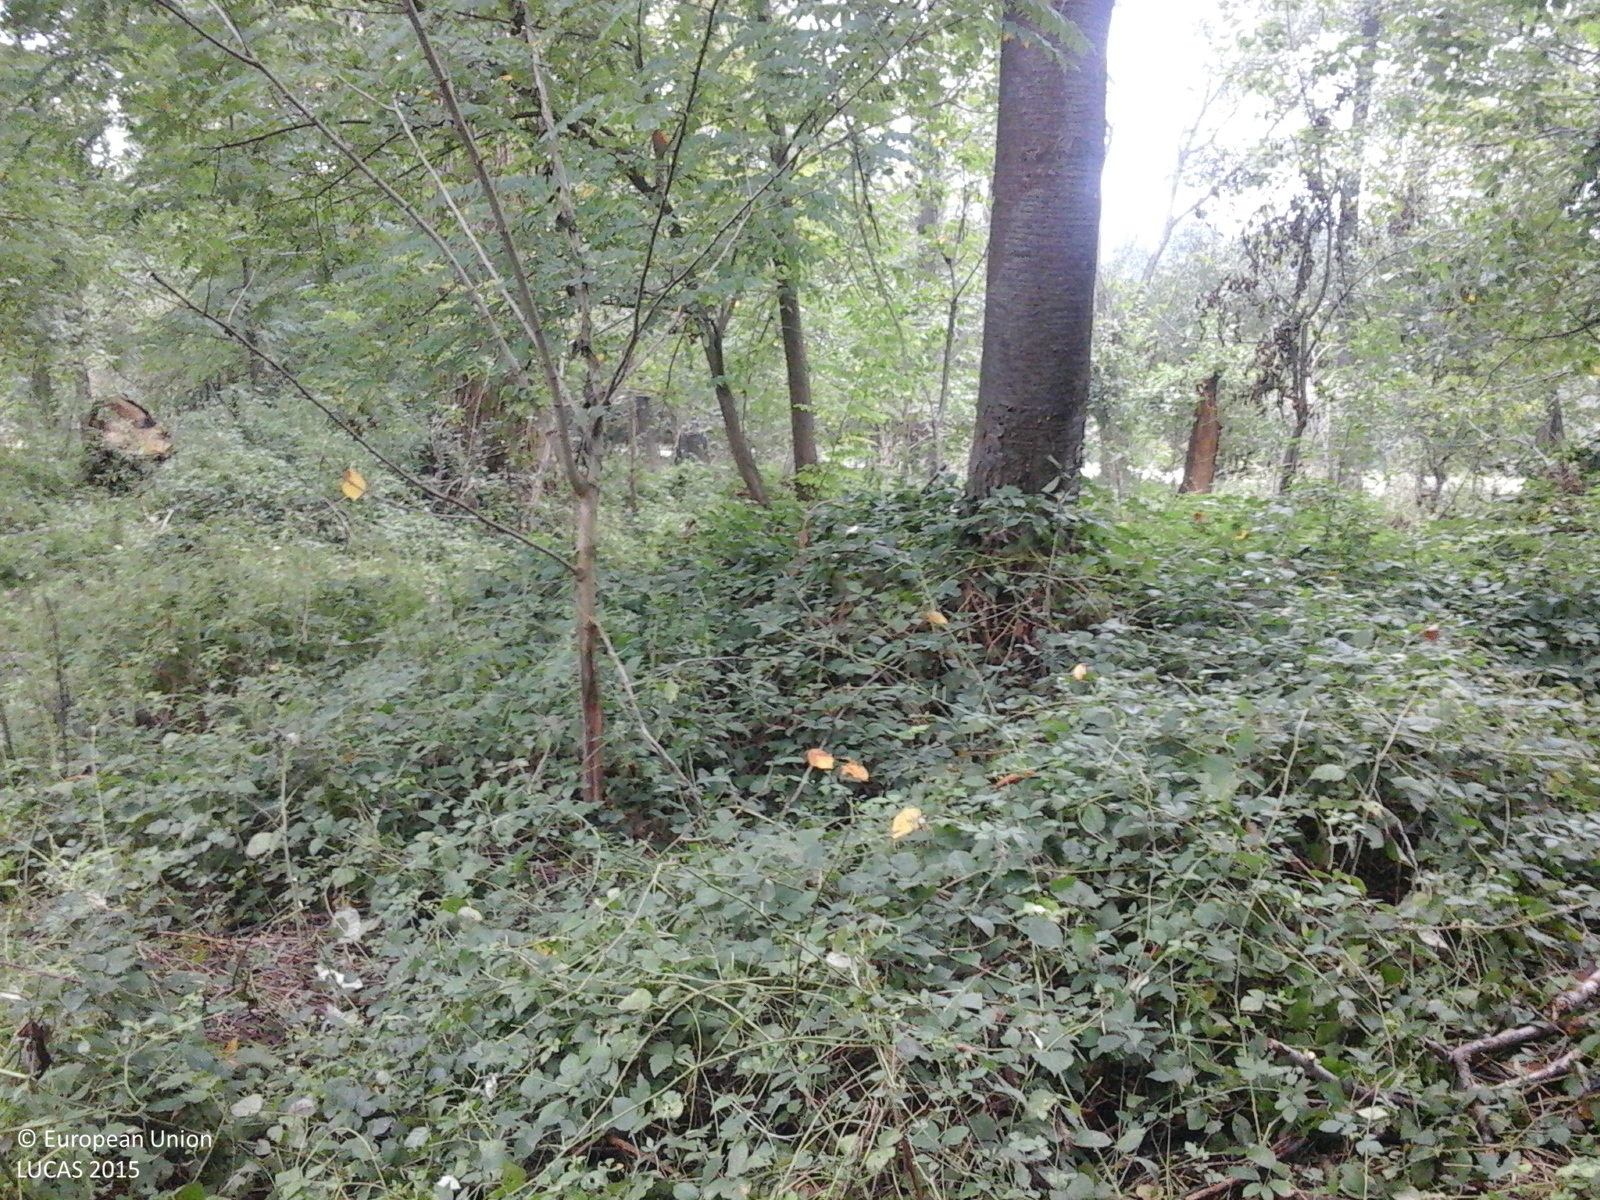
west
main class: Woodland
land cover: Broadleaved woodland
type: acidophilous oak and oak-birch forest
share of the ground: > 75 %
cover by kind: broadleaved forest trees 100 %
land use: Forestry
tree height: > 5 m
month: September
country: RO
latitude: 45.1228
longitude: 23.2374
